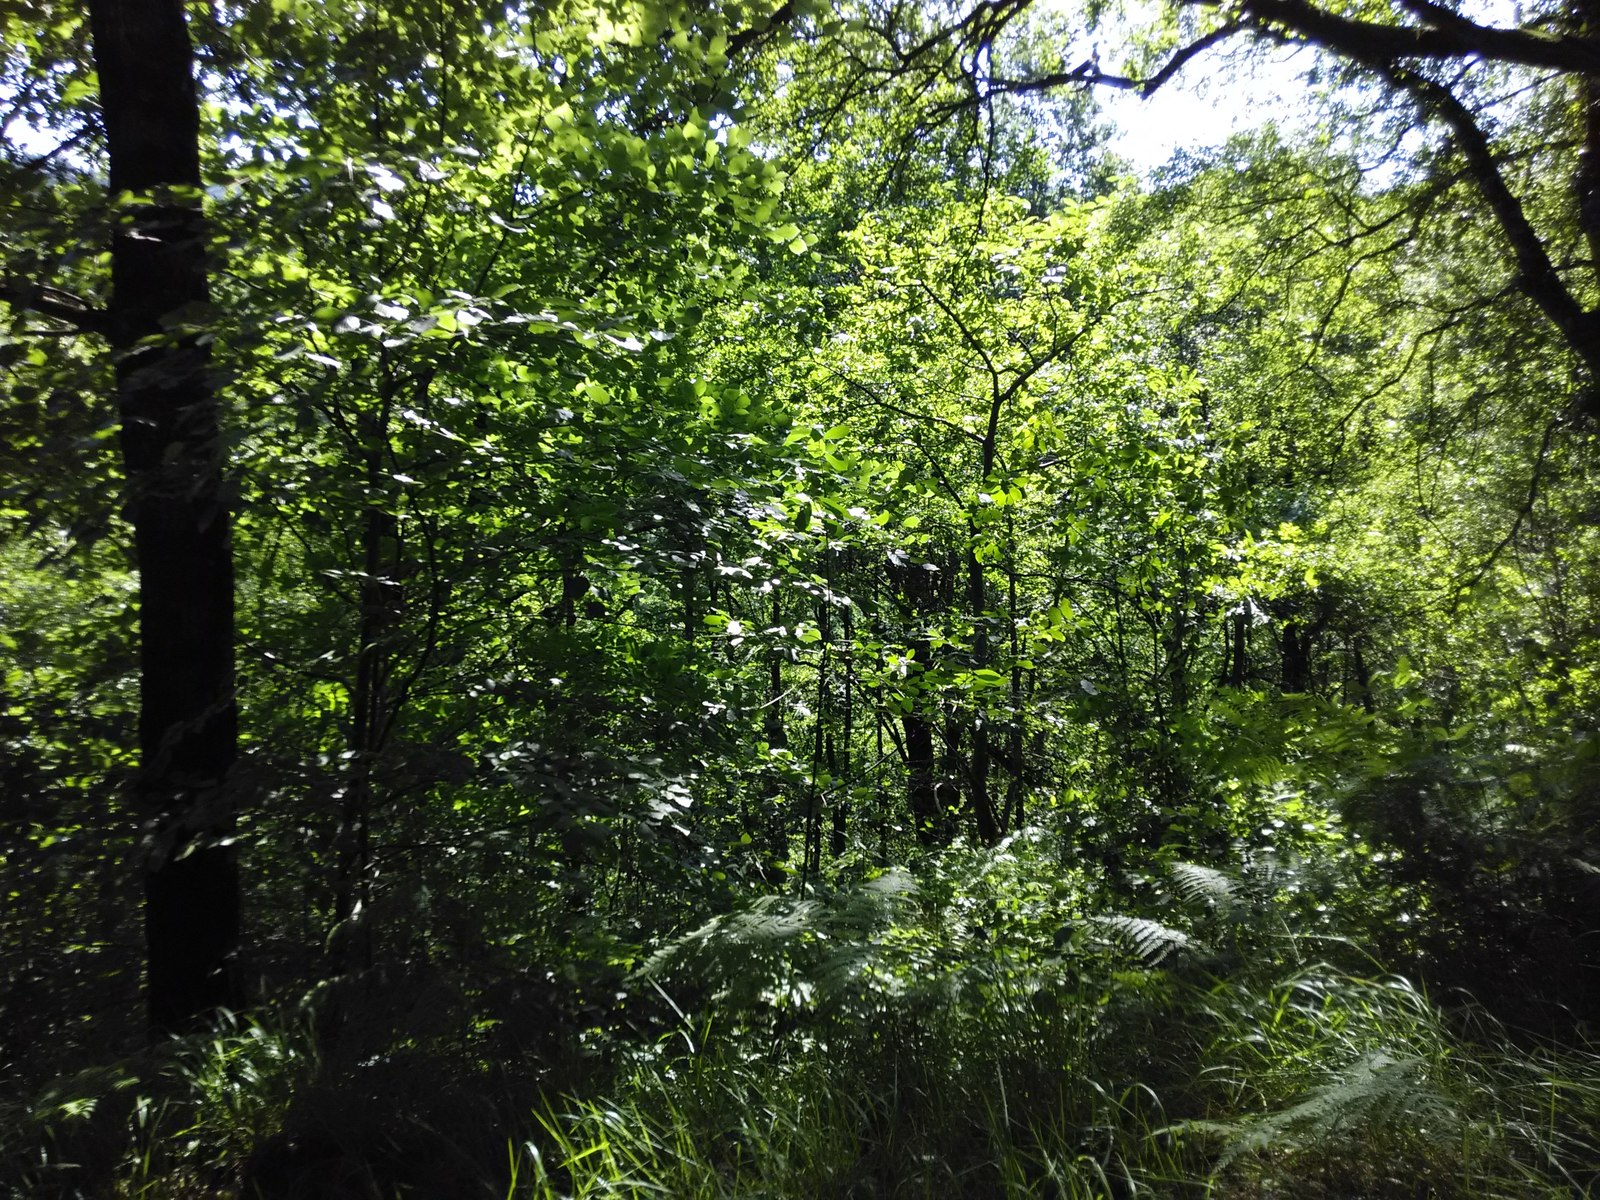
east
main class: Woodland
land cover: Broadleaved woodland
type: acidophilous oak and oak-birch forest
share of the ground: > 75 %
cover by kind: broadleaved forest trees 90 %, unconsolidated bare surface 10 %
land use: Forestry
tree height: > 5 m
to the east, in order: Broadleaved woodland; Tracks; Broadleaved woodland; Tracks; Broadleaved woodland; Grassland with sparse tree/shrub cover; Tracks; Grassland with sparse tree/shrub cover; Grassland without tree/shrub cover
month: July
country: ES
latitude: 43.0044
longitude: -2.2290
